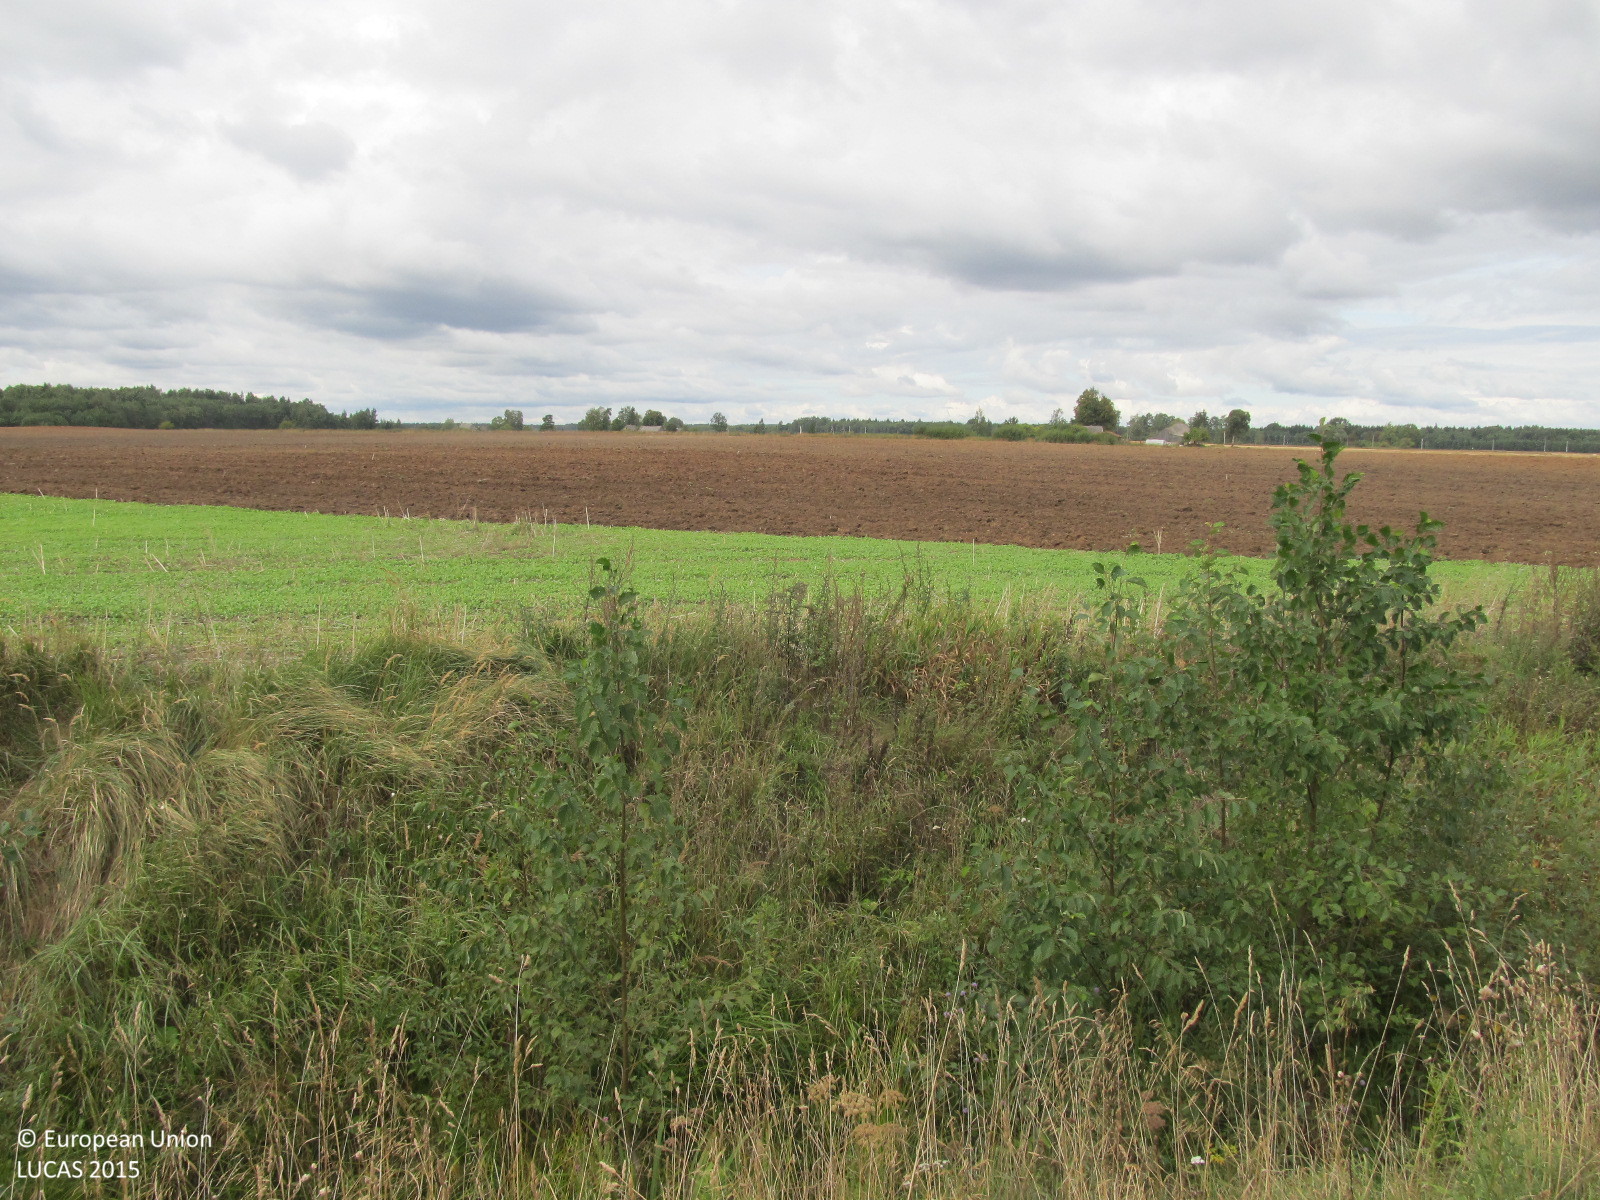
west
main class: Cropland
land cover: Rape and turnip rape
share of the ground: 50 - 75 %
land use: Agriculture (excluding fallow land and kitchen gardens)
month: September
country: LT
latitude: 56.2763
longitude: 23.2993
